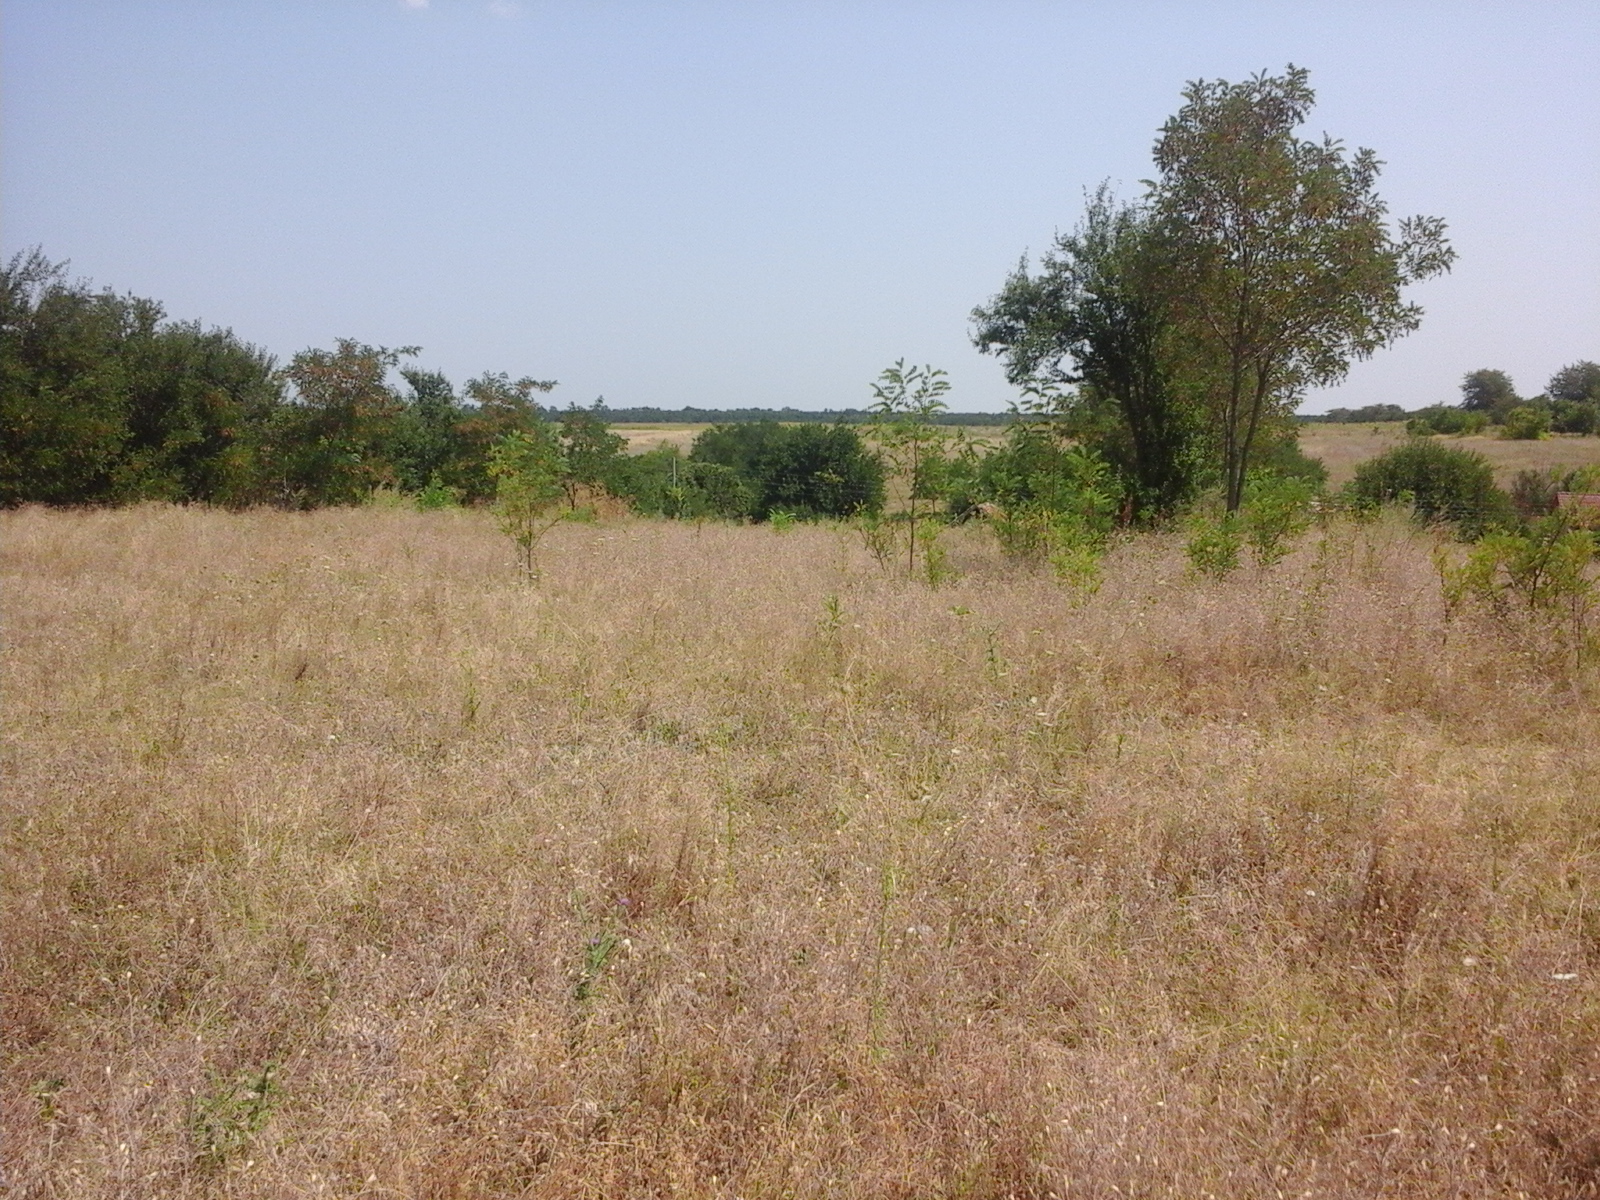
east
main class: Grassland
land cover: Grassland without tree/shrub cover
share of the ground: > 75 %
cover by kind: herbaceous plants 100 %
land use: Agriculture (excluding fallow land and kitchen gardens)
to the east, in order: Grassland without tree/shrub cover; Abandoned hedges; Spontaneously vegetated surfaces; Artificial constructions in urban areas; Shrubland with sparse tree cover; Spontaneously vegetated surfaces
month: August
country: RO
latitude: 44.1975
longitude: 23.4763
